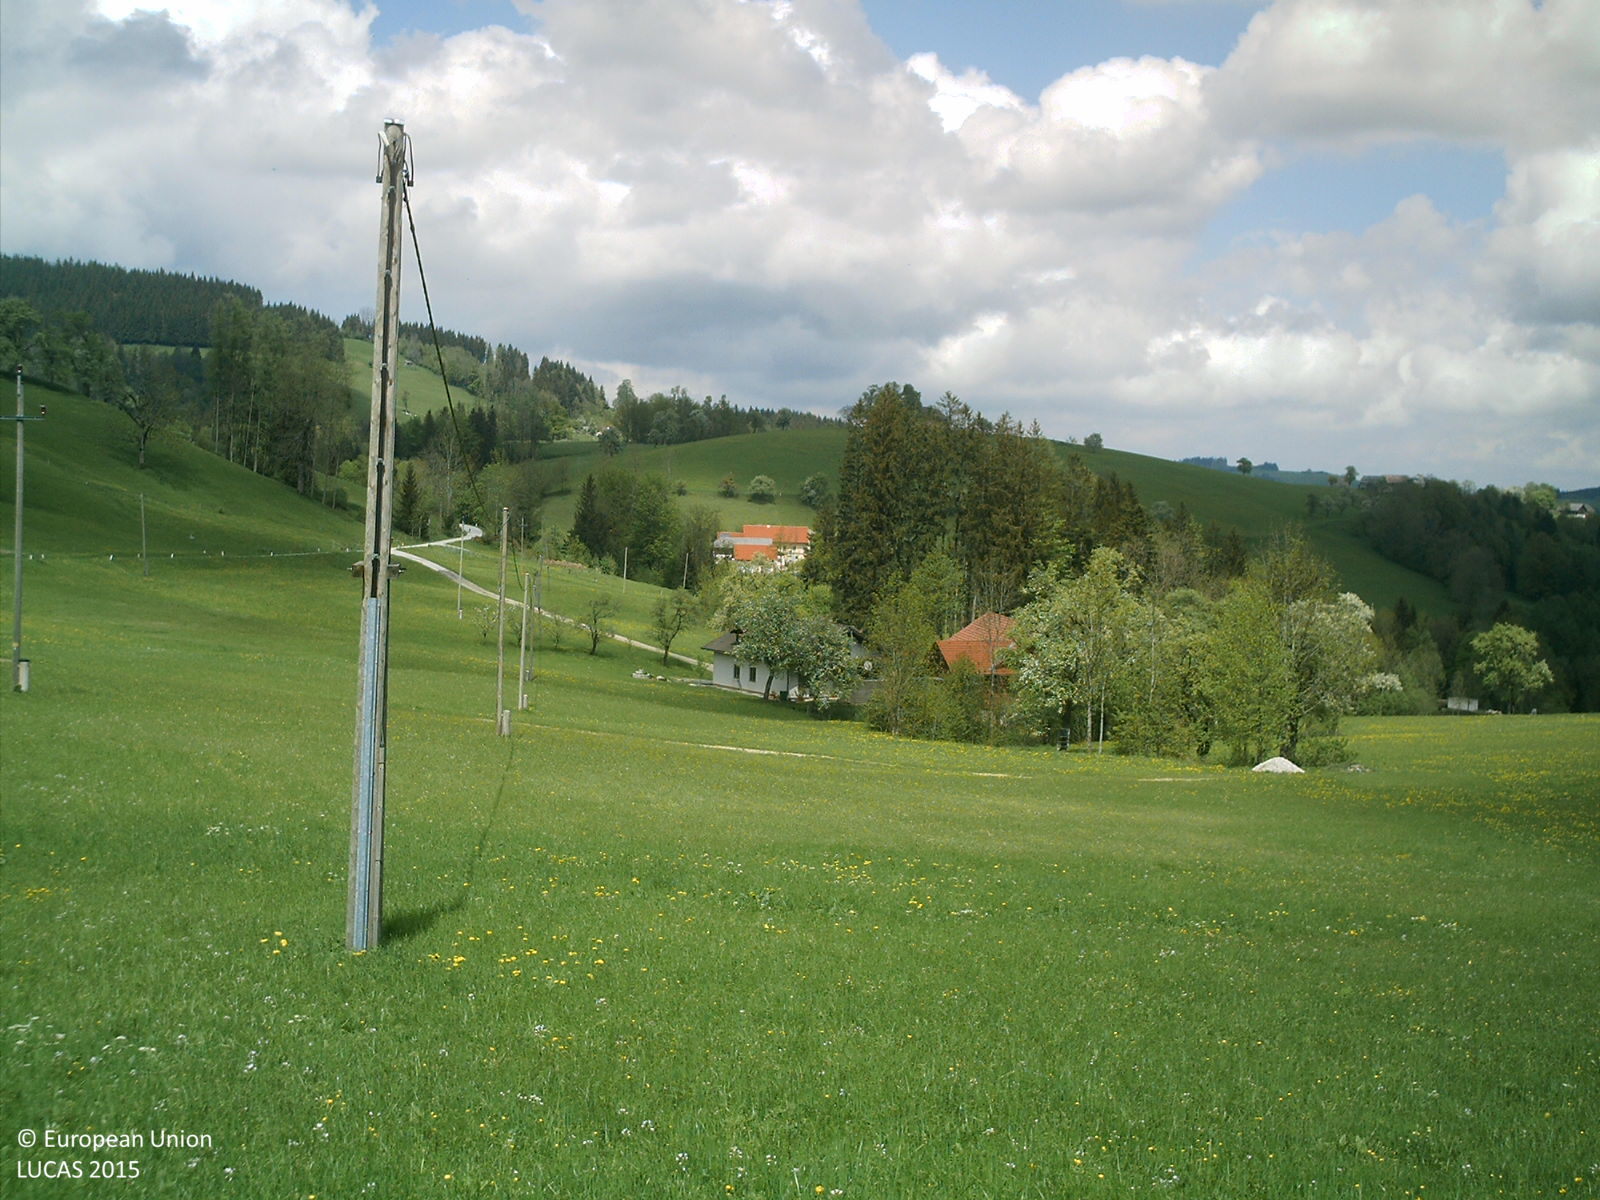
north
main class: Grassland
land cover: Grassland without tree/shrub cover
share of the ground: > 75 %
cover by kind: herbaceous plants 100 %
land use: Agriculture (excluding fallow land and kitchen gardens)
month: May
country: AT
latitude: 47.8928
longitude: 14.1591
